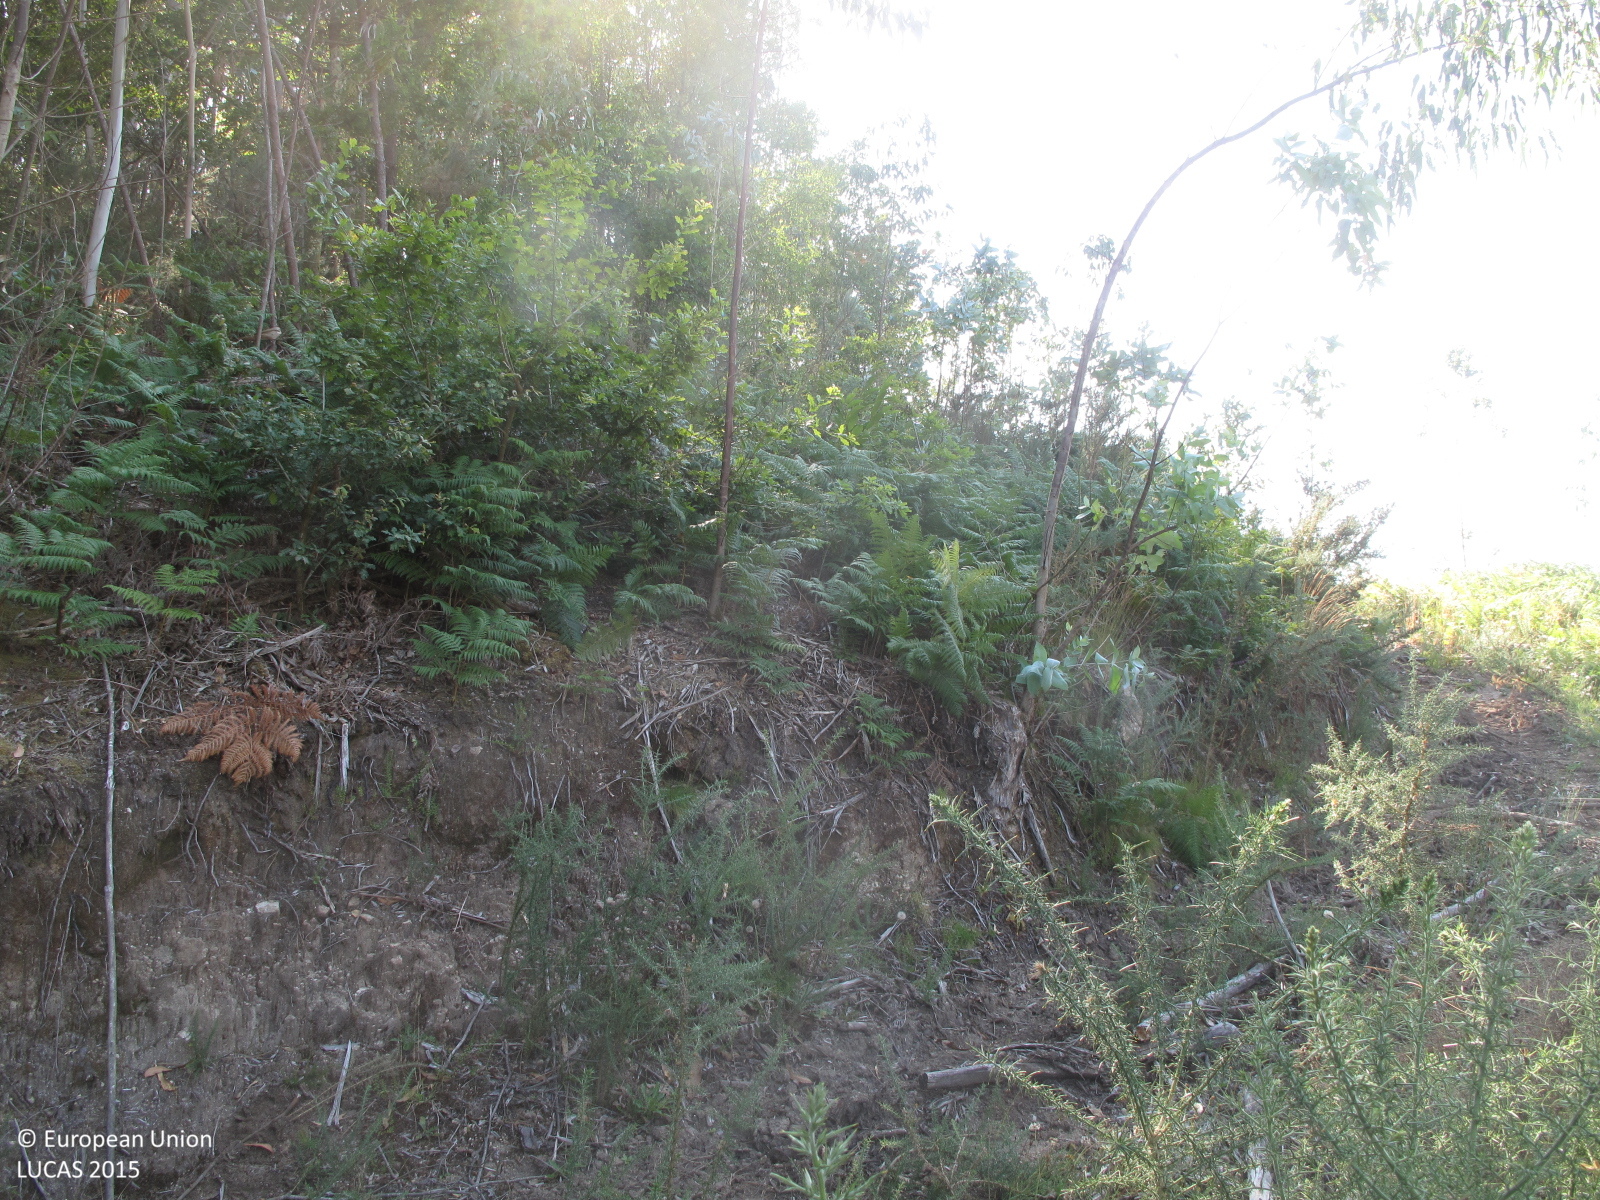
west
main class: Grassland
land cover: Grassland with sparse tree/shrub cover
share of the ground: 50 - 75 %
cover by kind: herbaceous plants 70 %, unconsolidated bare surface 20 %, broadleaved forest trees 5 %, shrubs 5 %
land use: Forestry
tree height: < 5 m
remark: Clear cut
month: July
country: ES
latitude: 43.3518
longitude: -8.0974
